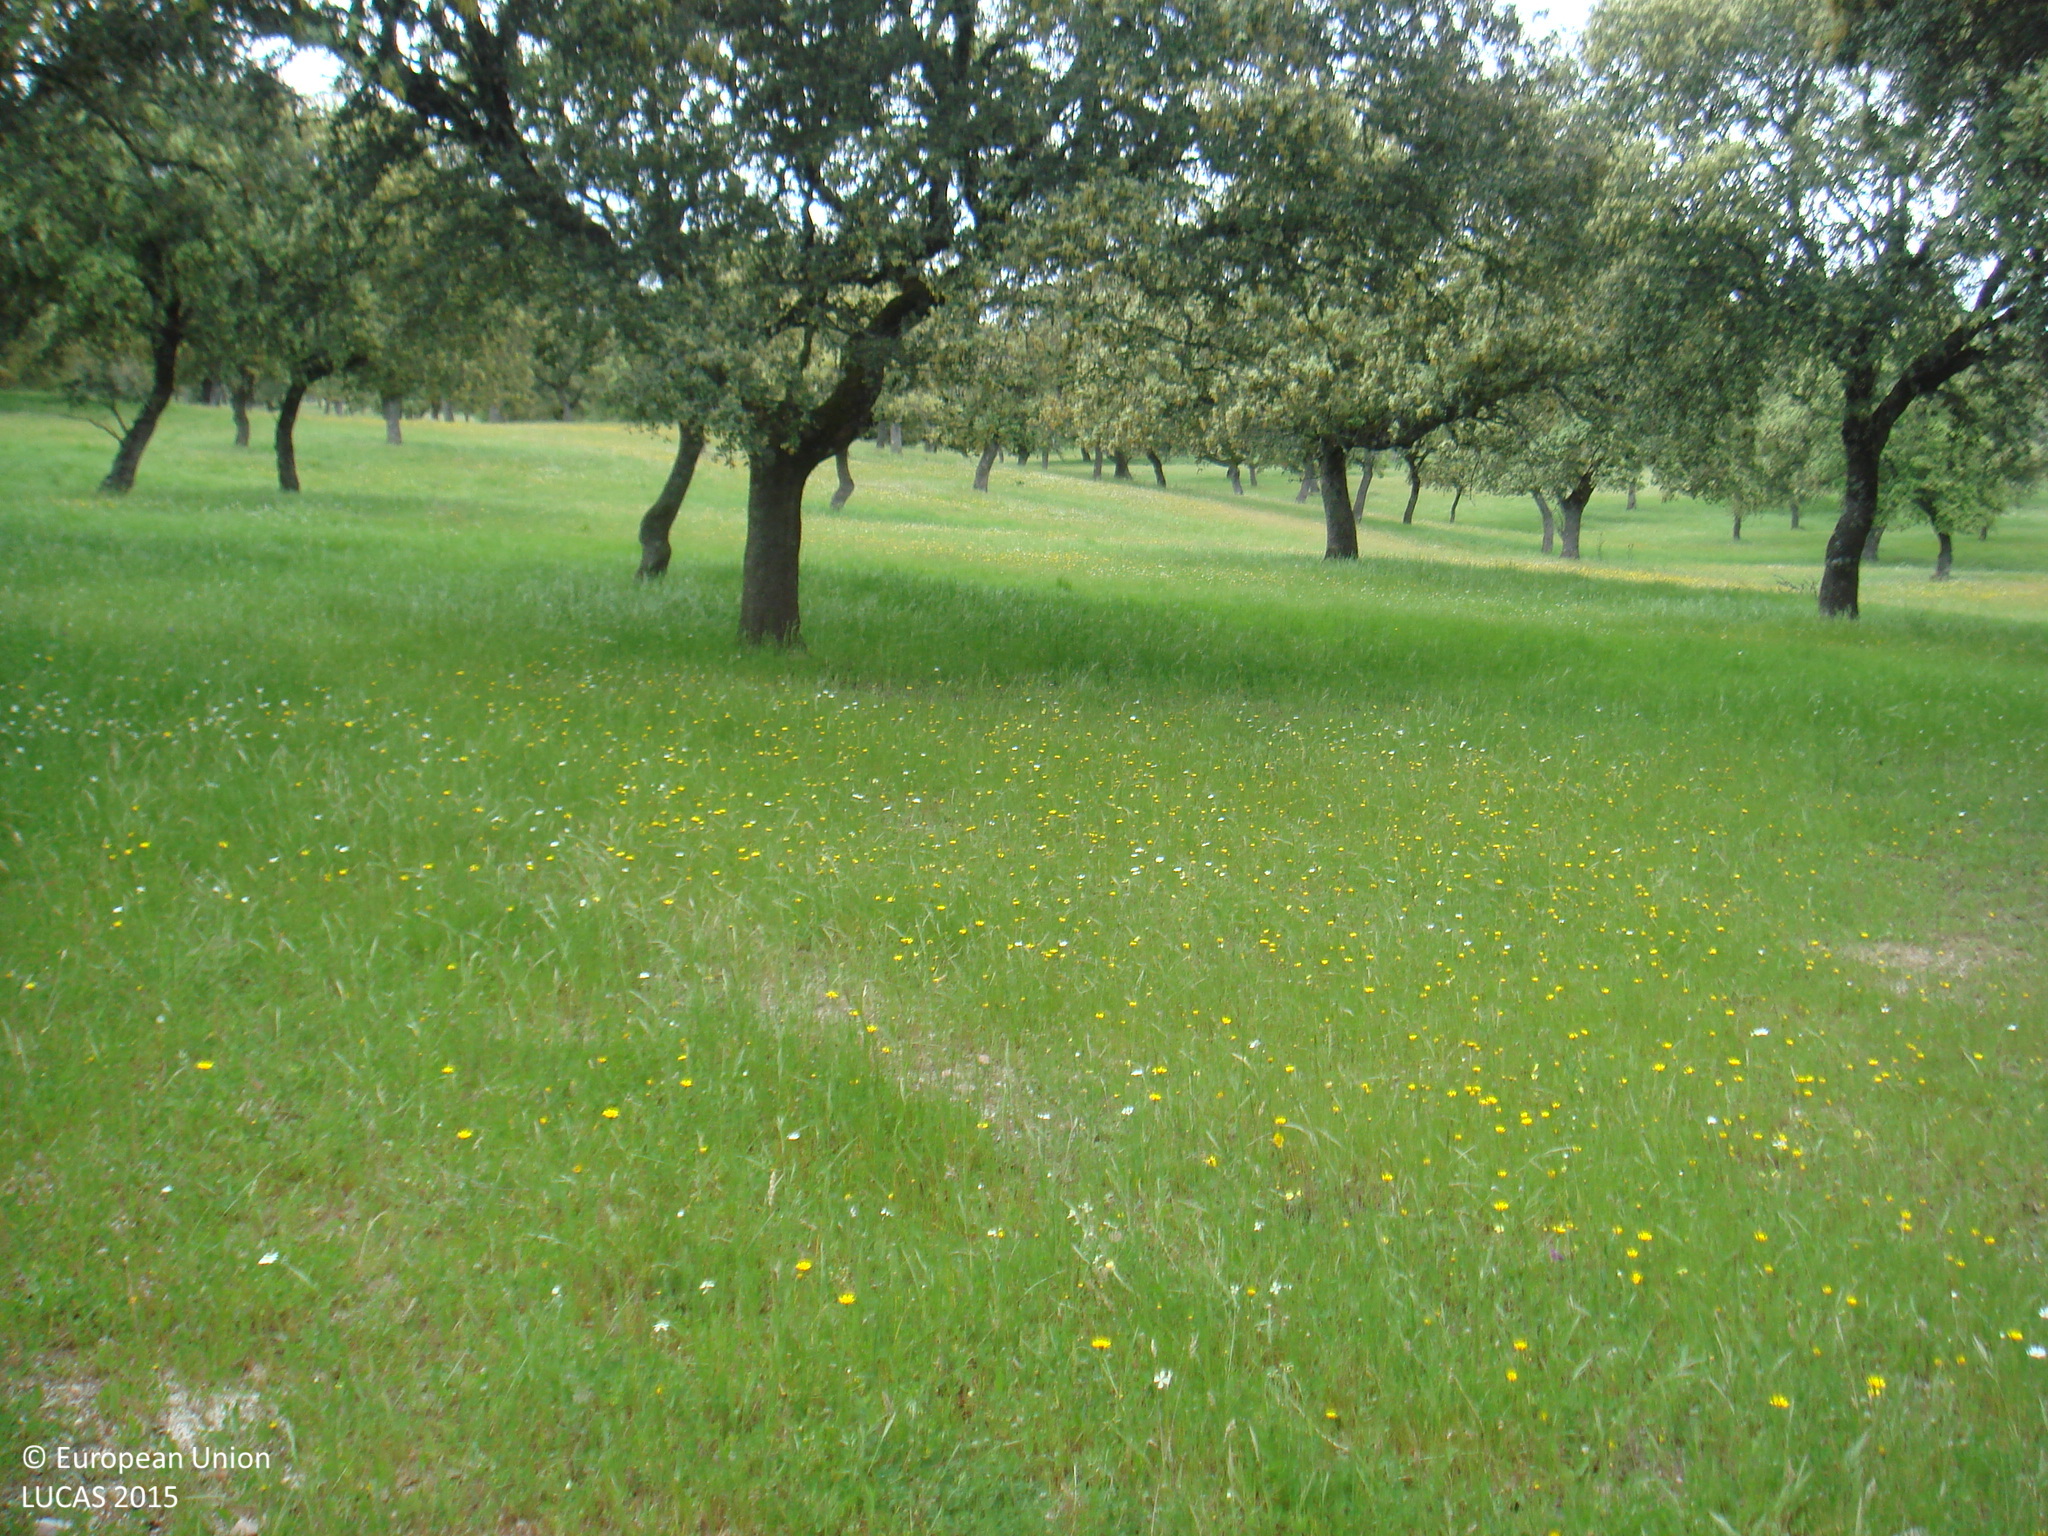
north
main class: Woodland
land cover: Broadleaved woodland
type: broadleaved evergreen forest
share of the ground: > 75 %
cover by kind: herbaceous plants 60 %, broadleaved forest trees 40 %
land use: Forestry
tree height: > 5 m
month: April
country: ES
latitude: 38.2366
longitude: -4.3295
